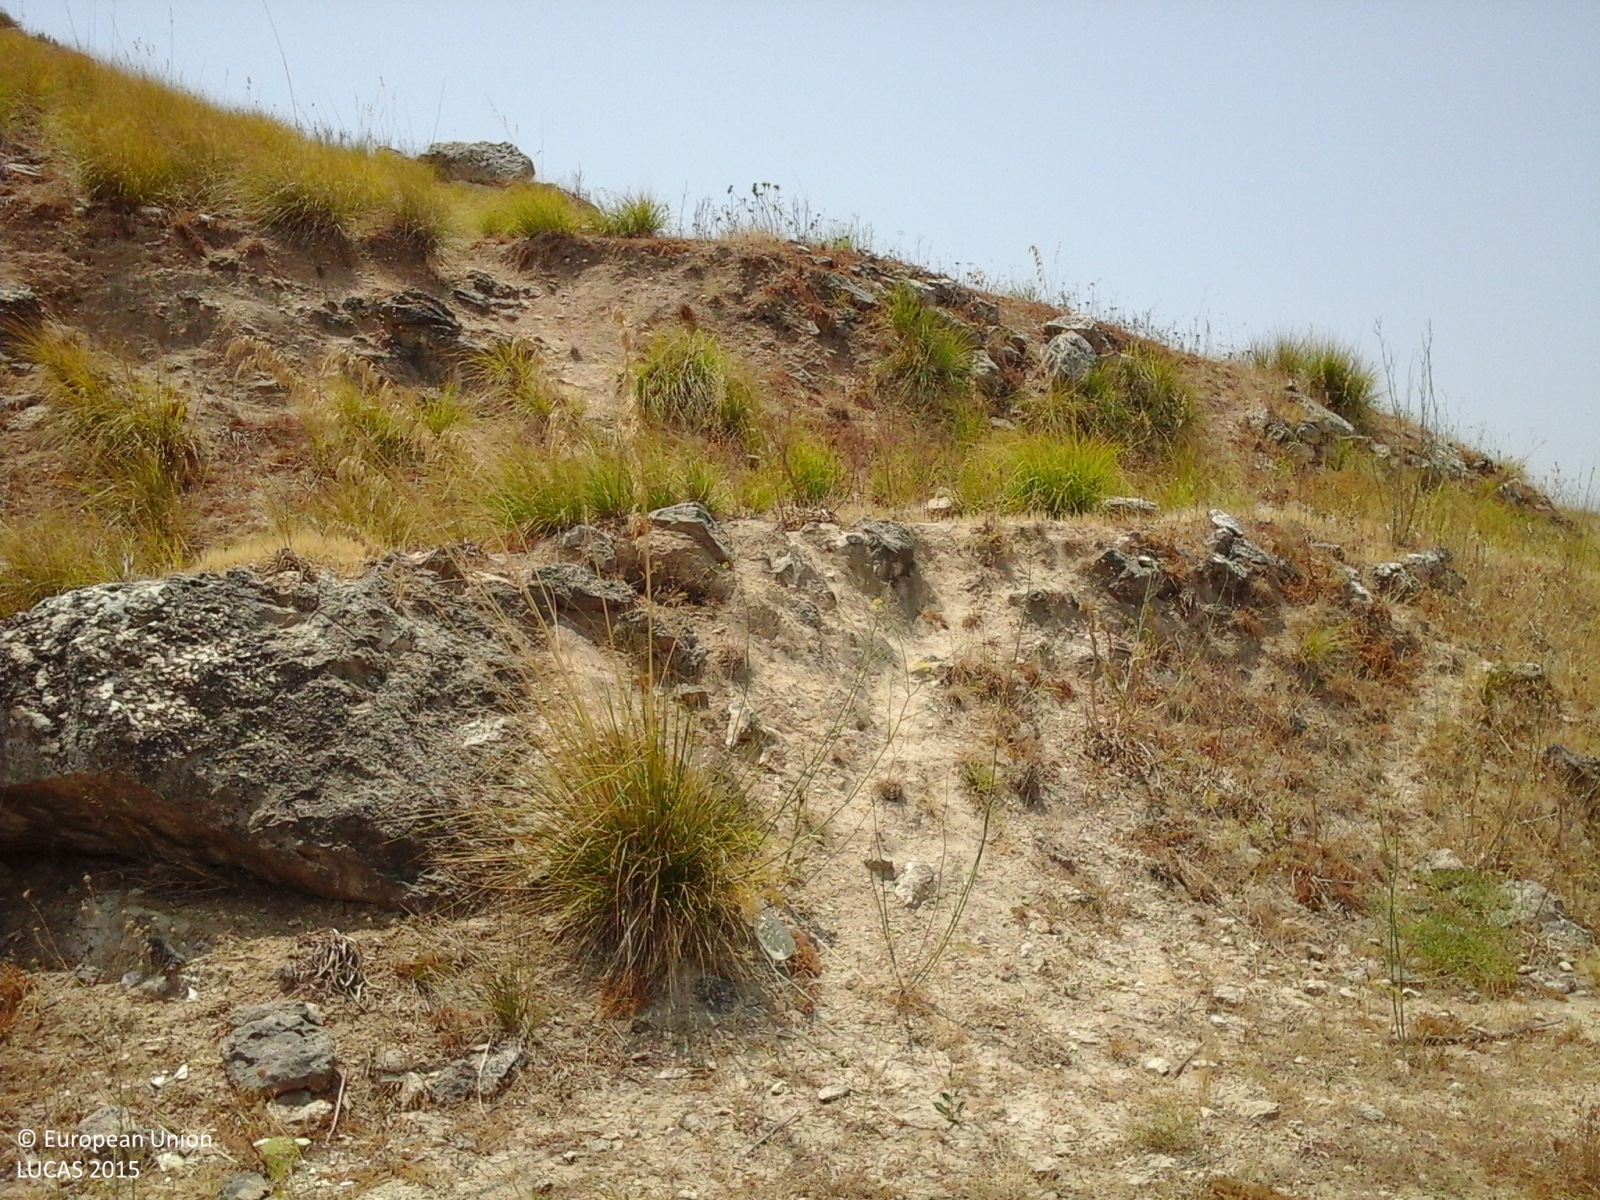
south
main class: Grassland
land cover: Grassland without tree/shrub cover
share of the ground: > 75 %
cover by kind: herbaceous plants 75 %, consolidated bare surface 25 %
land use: Semi-natural and natural areas not in use
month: July
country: IT
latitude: 37.3162
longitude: 14.0424
